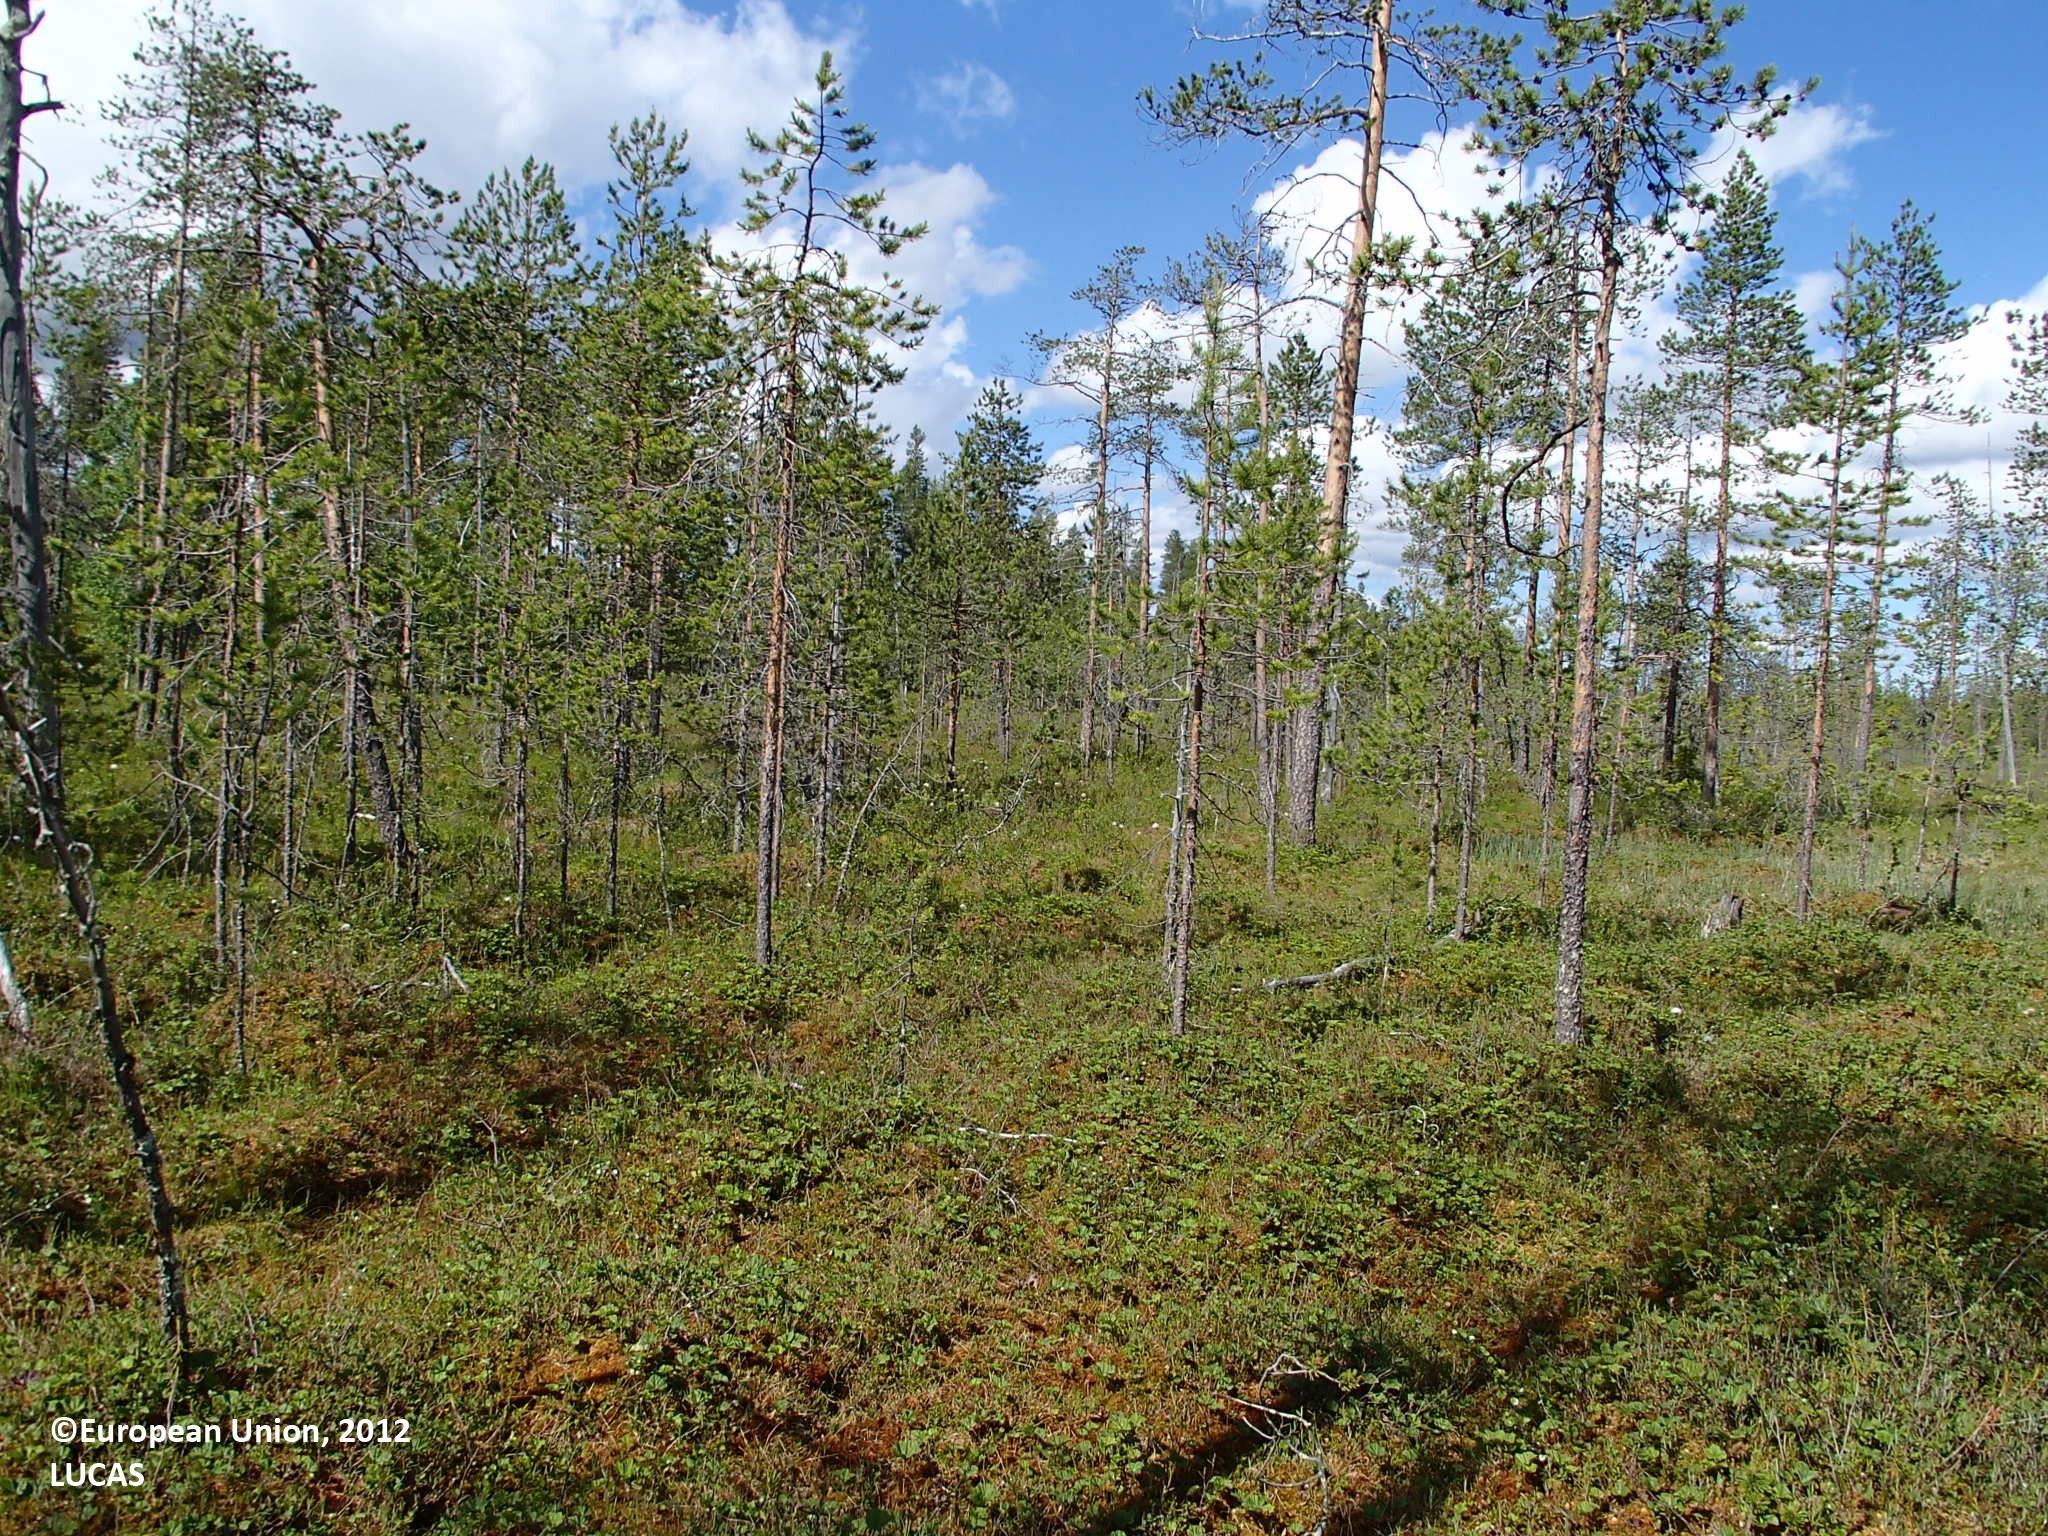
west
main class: Woodland
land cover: Pine dominated coniferous woodland
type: boreal forest
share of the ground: 10 - 25 %
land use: Forestry
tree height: > 5 m
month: July
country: FI
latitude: 67.3293
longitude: 26.7502
